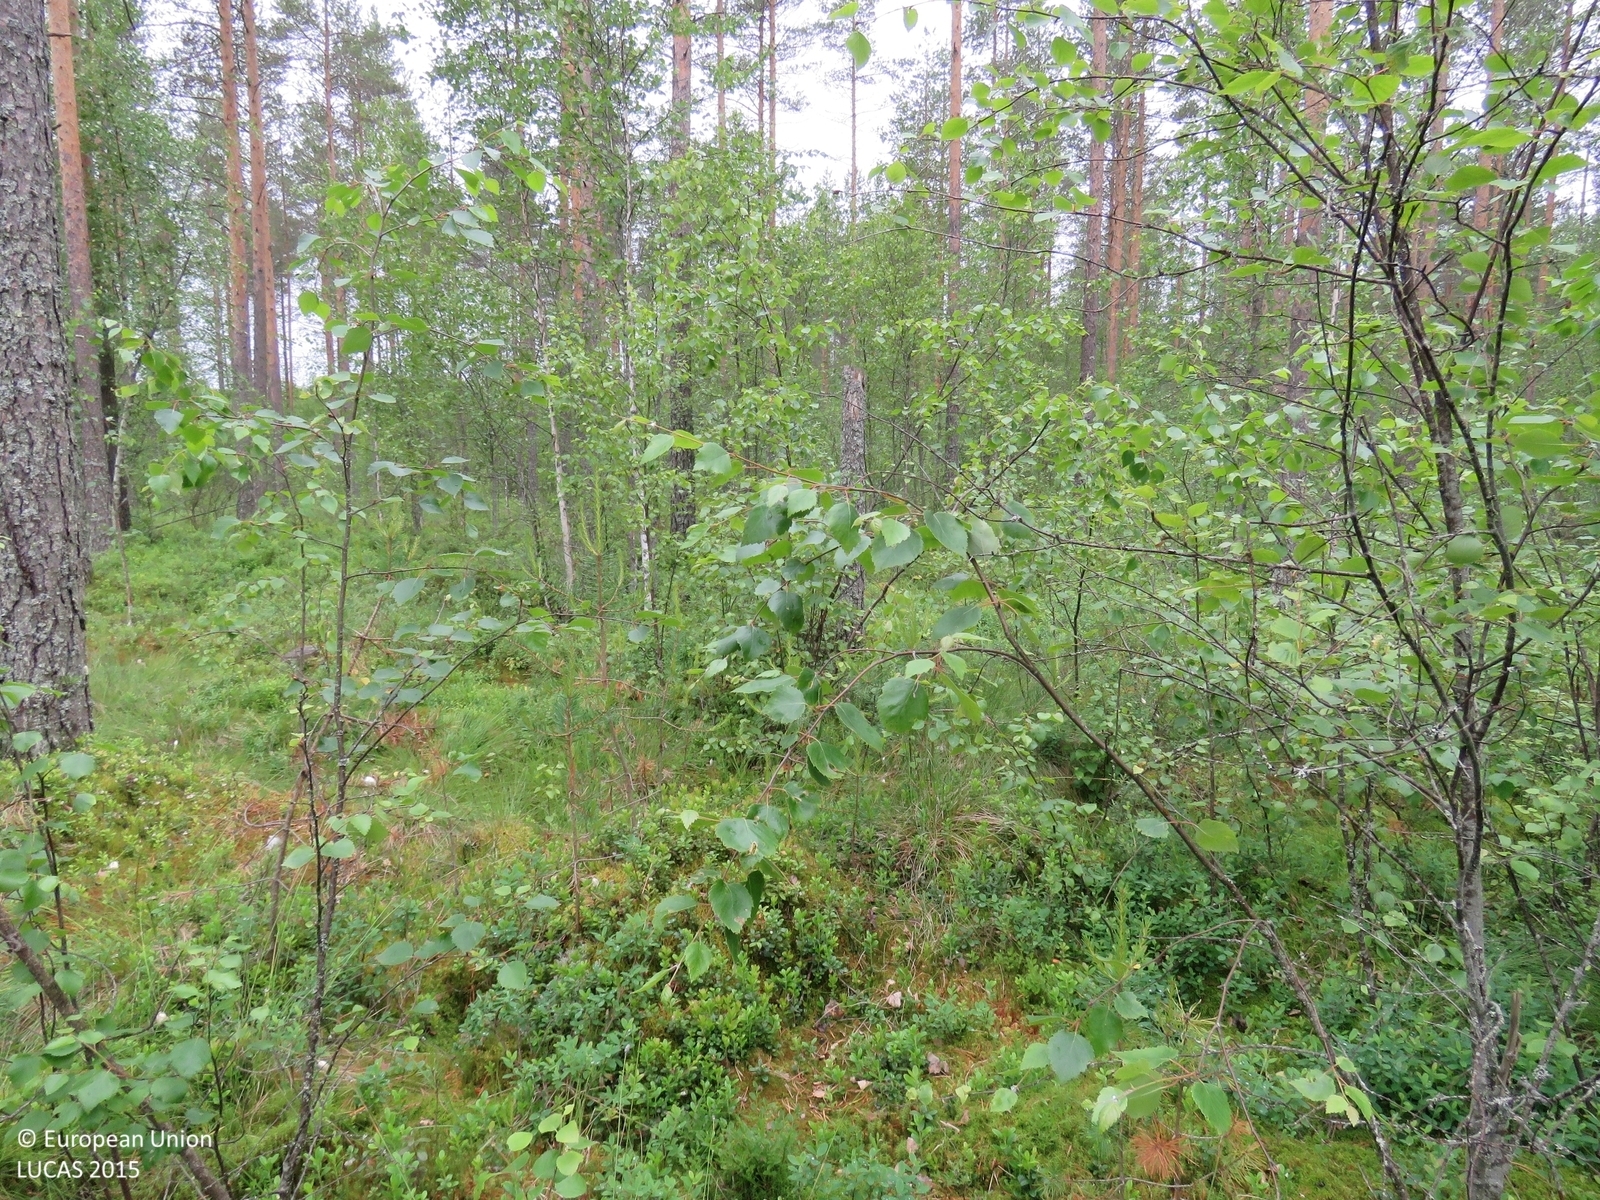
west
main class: Woodland
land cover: Pine dominated mixed woodland
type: boreal forest
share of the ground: > 75 %
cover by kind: broadleaved forest trees 50 %, coniferous forest trees 40 %, shrubs 5 %, herbaceous plants 5 %
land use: Forestry
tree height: > 5 m
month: July
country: FI
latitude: 64.3939
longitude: 26.3499
